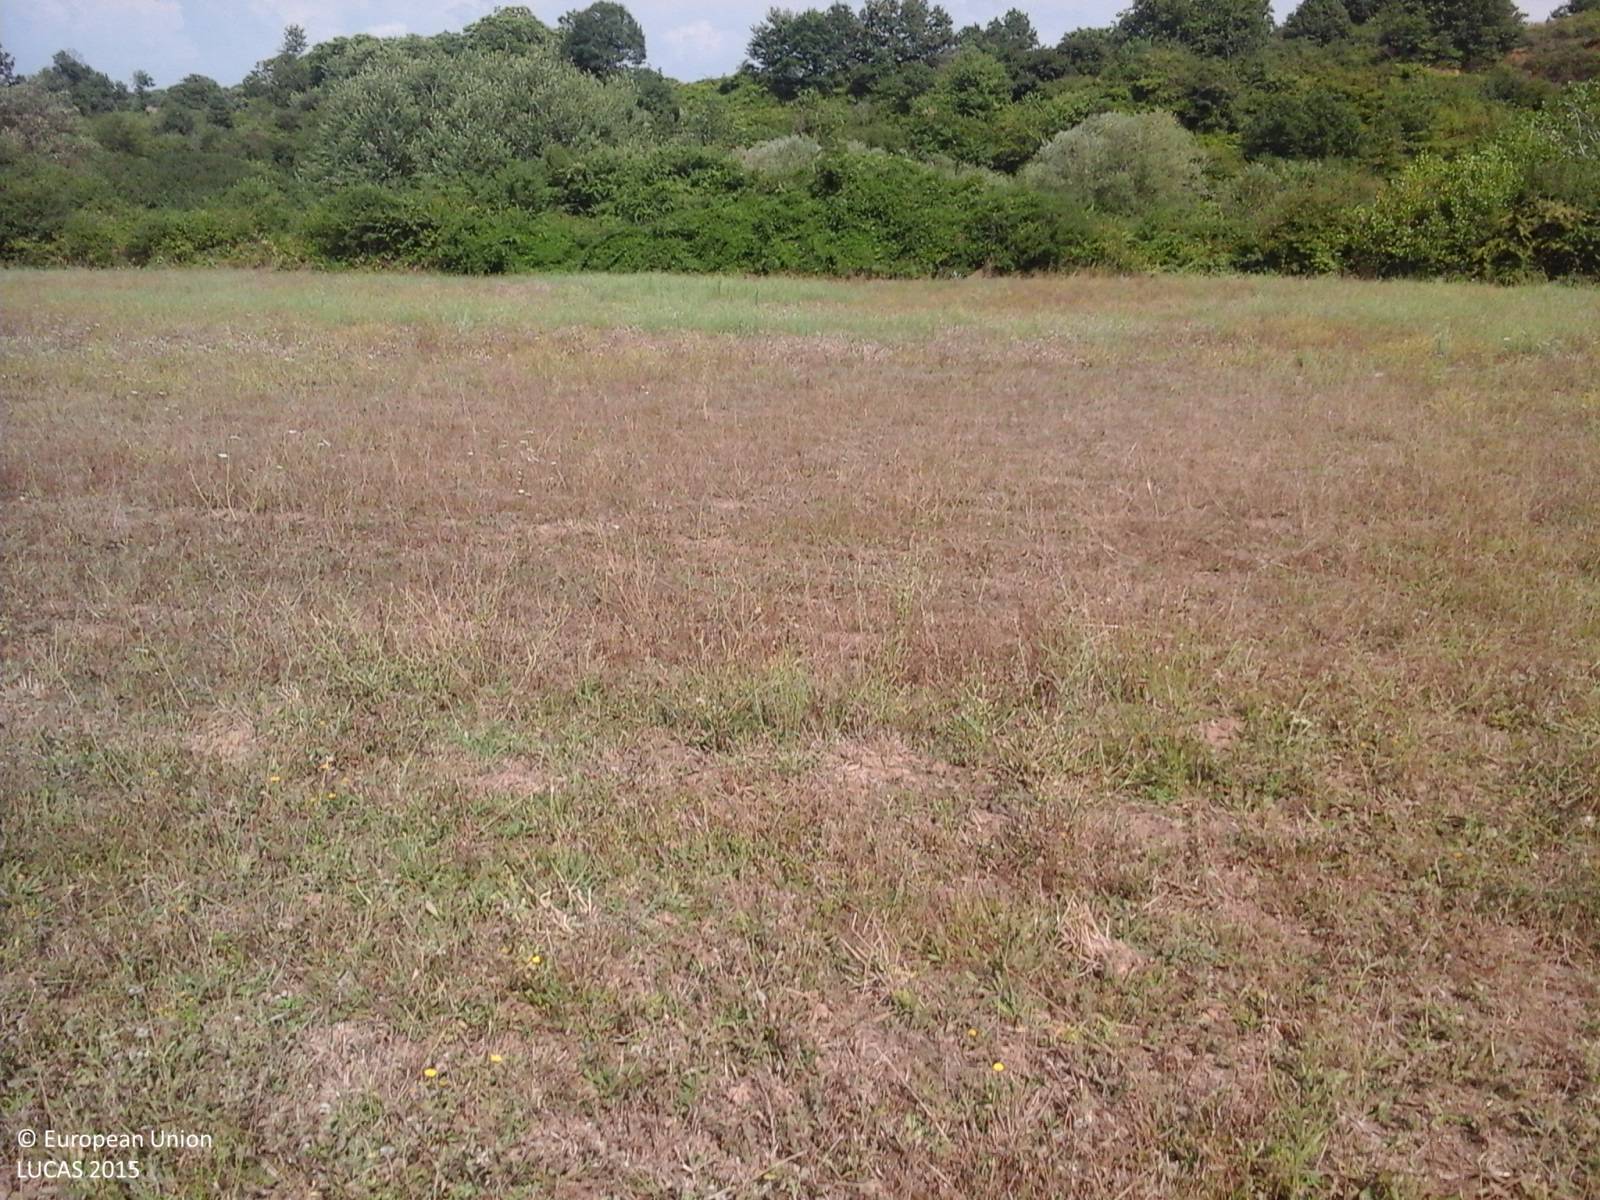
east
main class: Cropland
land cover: Mixed cereals for fodder
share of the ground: > 75 %
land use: Agriculture (excluding fallow land and kitchen gardens)
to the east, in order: Mixed cereals for fodder; Broadleaved woodland; Grassland without tree/shrub cover; Broadleaved woodland; Grassland without tree/shrub cover; Fences; Tracks; Managed hedges; Tracks; Abandoned hedges
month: August
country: IT
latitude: 42.2350
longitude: 12.0889
